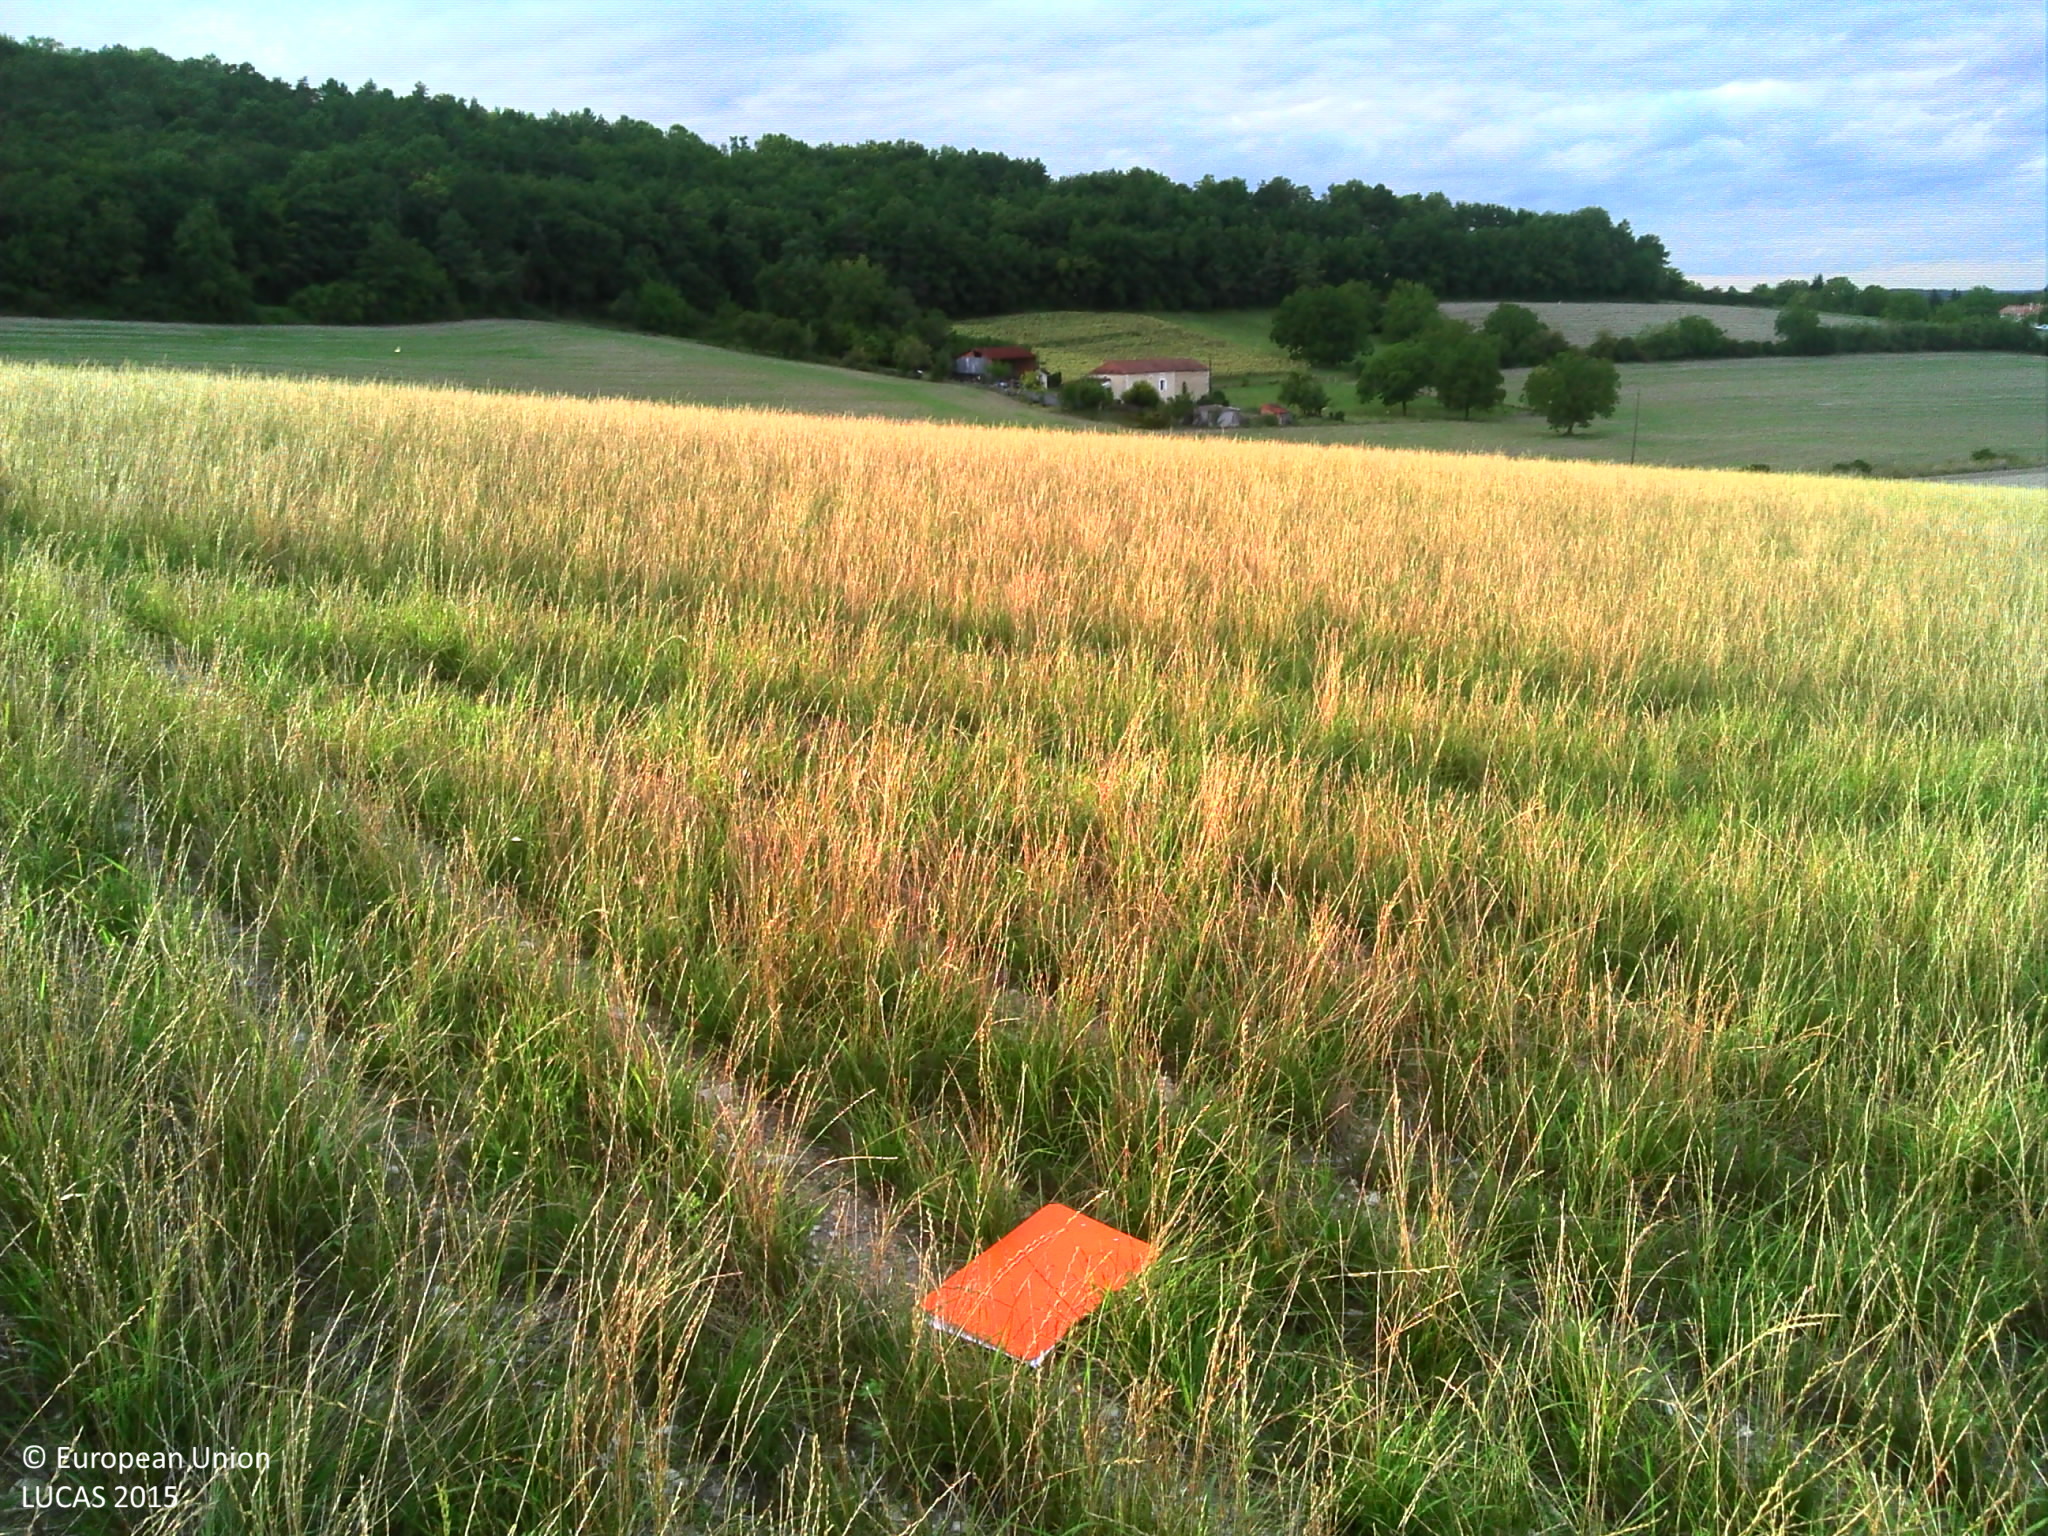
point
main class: Cropland
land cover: Temporary grasslands
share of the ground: > 75 %
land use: Agriculture (excluding fallow land and kitchen gardens)
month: August
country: FR
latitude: 45.2226
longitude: 0.5263
